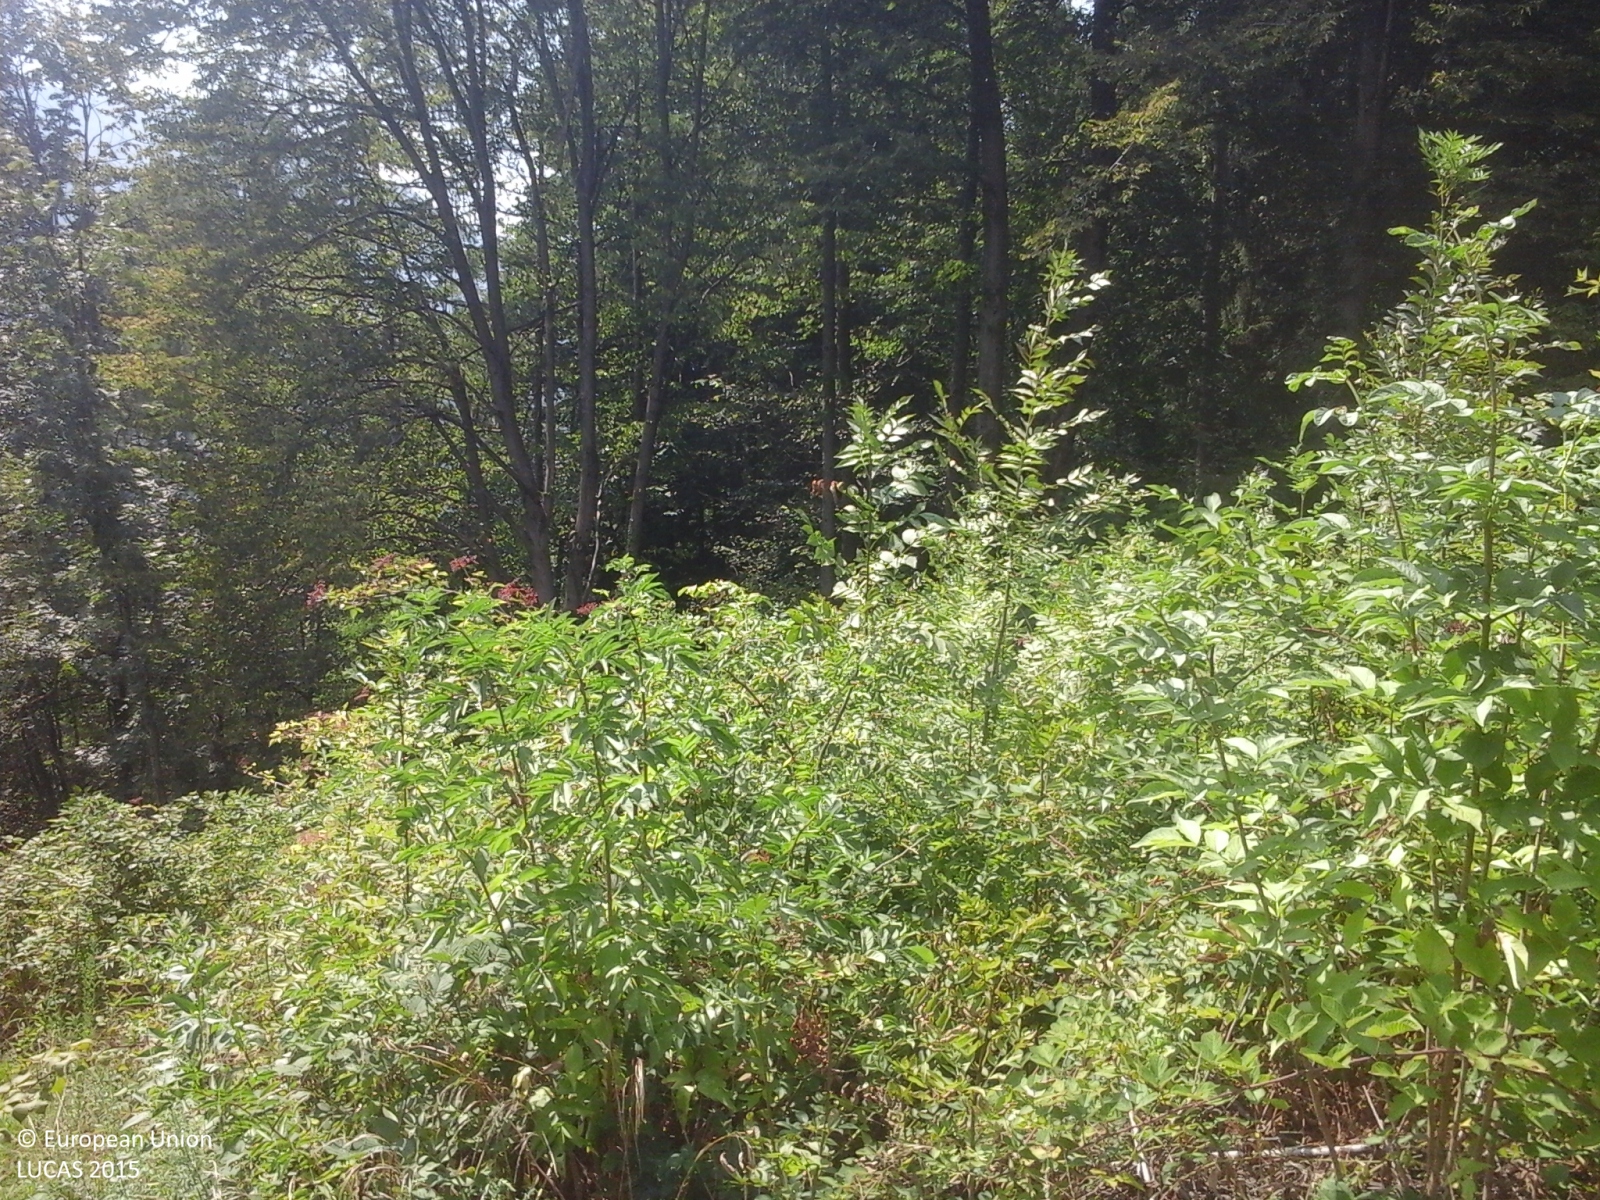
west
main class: Woodland
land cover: Broadleaved woodland
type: thermophilous deciduous forest
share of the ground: > 75 %
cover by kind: broadleaved forest trees 80 %, coniferous forest trees 10 %, shrubs 5 %, herbaceous plants 5 %
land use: Forestry
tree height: > 5 m
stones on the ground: > 50 %
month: August
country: IT
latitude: 46.0251
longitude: 9.3679
